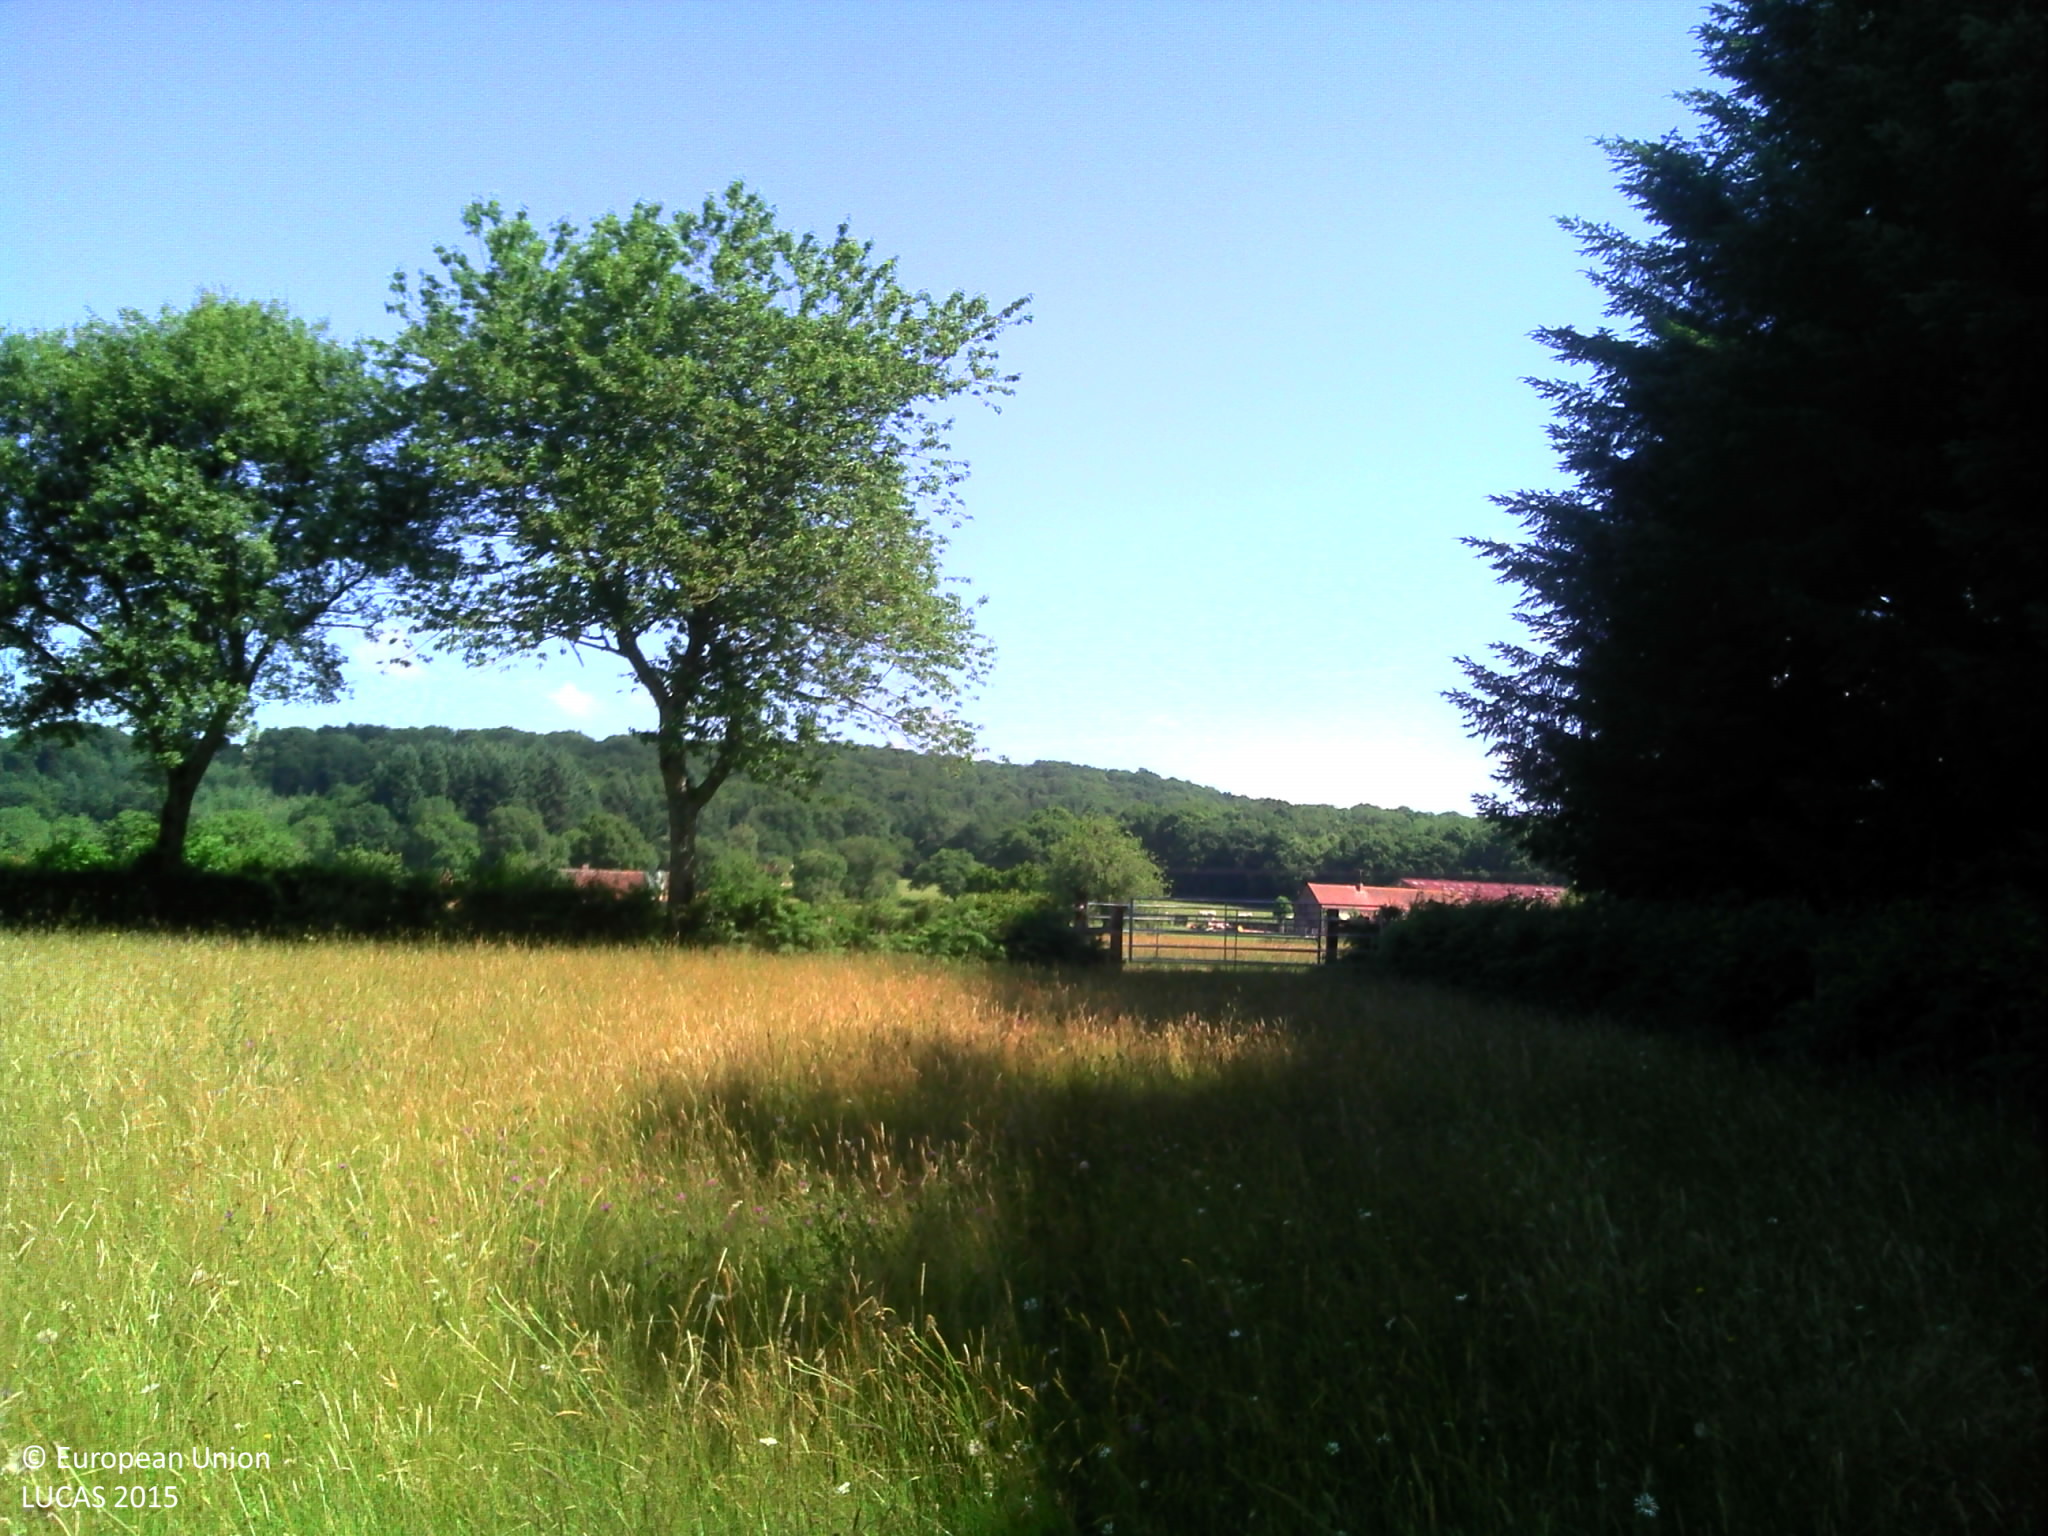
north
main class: Grassland
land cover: Grassland without tree/shrub cover
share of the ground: > 75 %
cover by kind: herbaceous plants 100 %
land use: Agriculture (excluding fallow land and kitchen gardens)
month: June
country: FR
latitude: 46.4567
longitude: 4.3896
